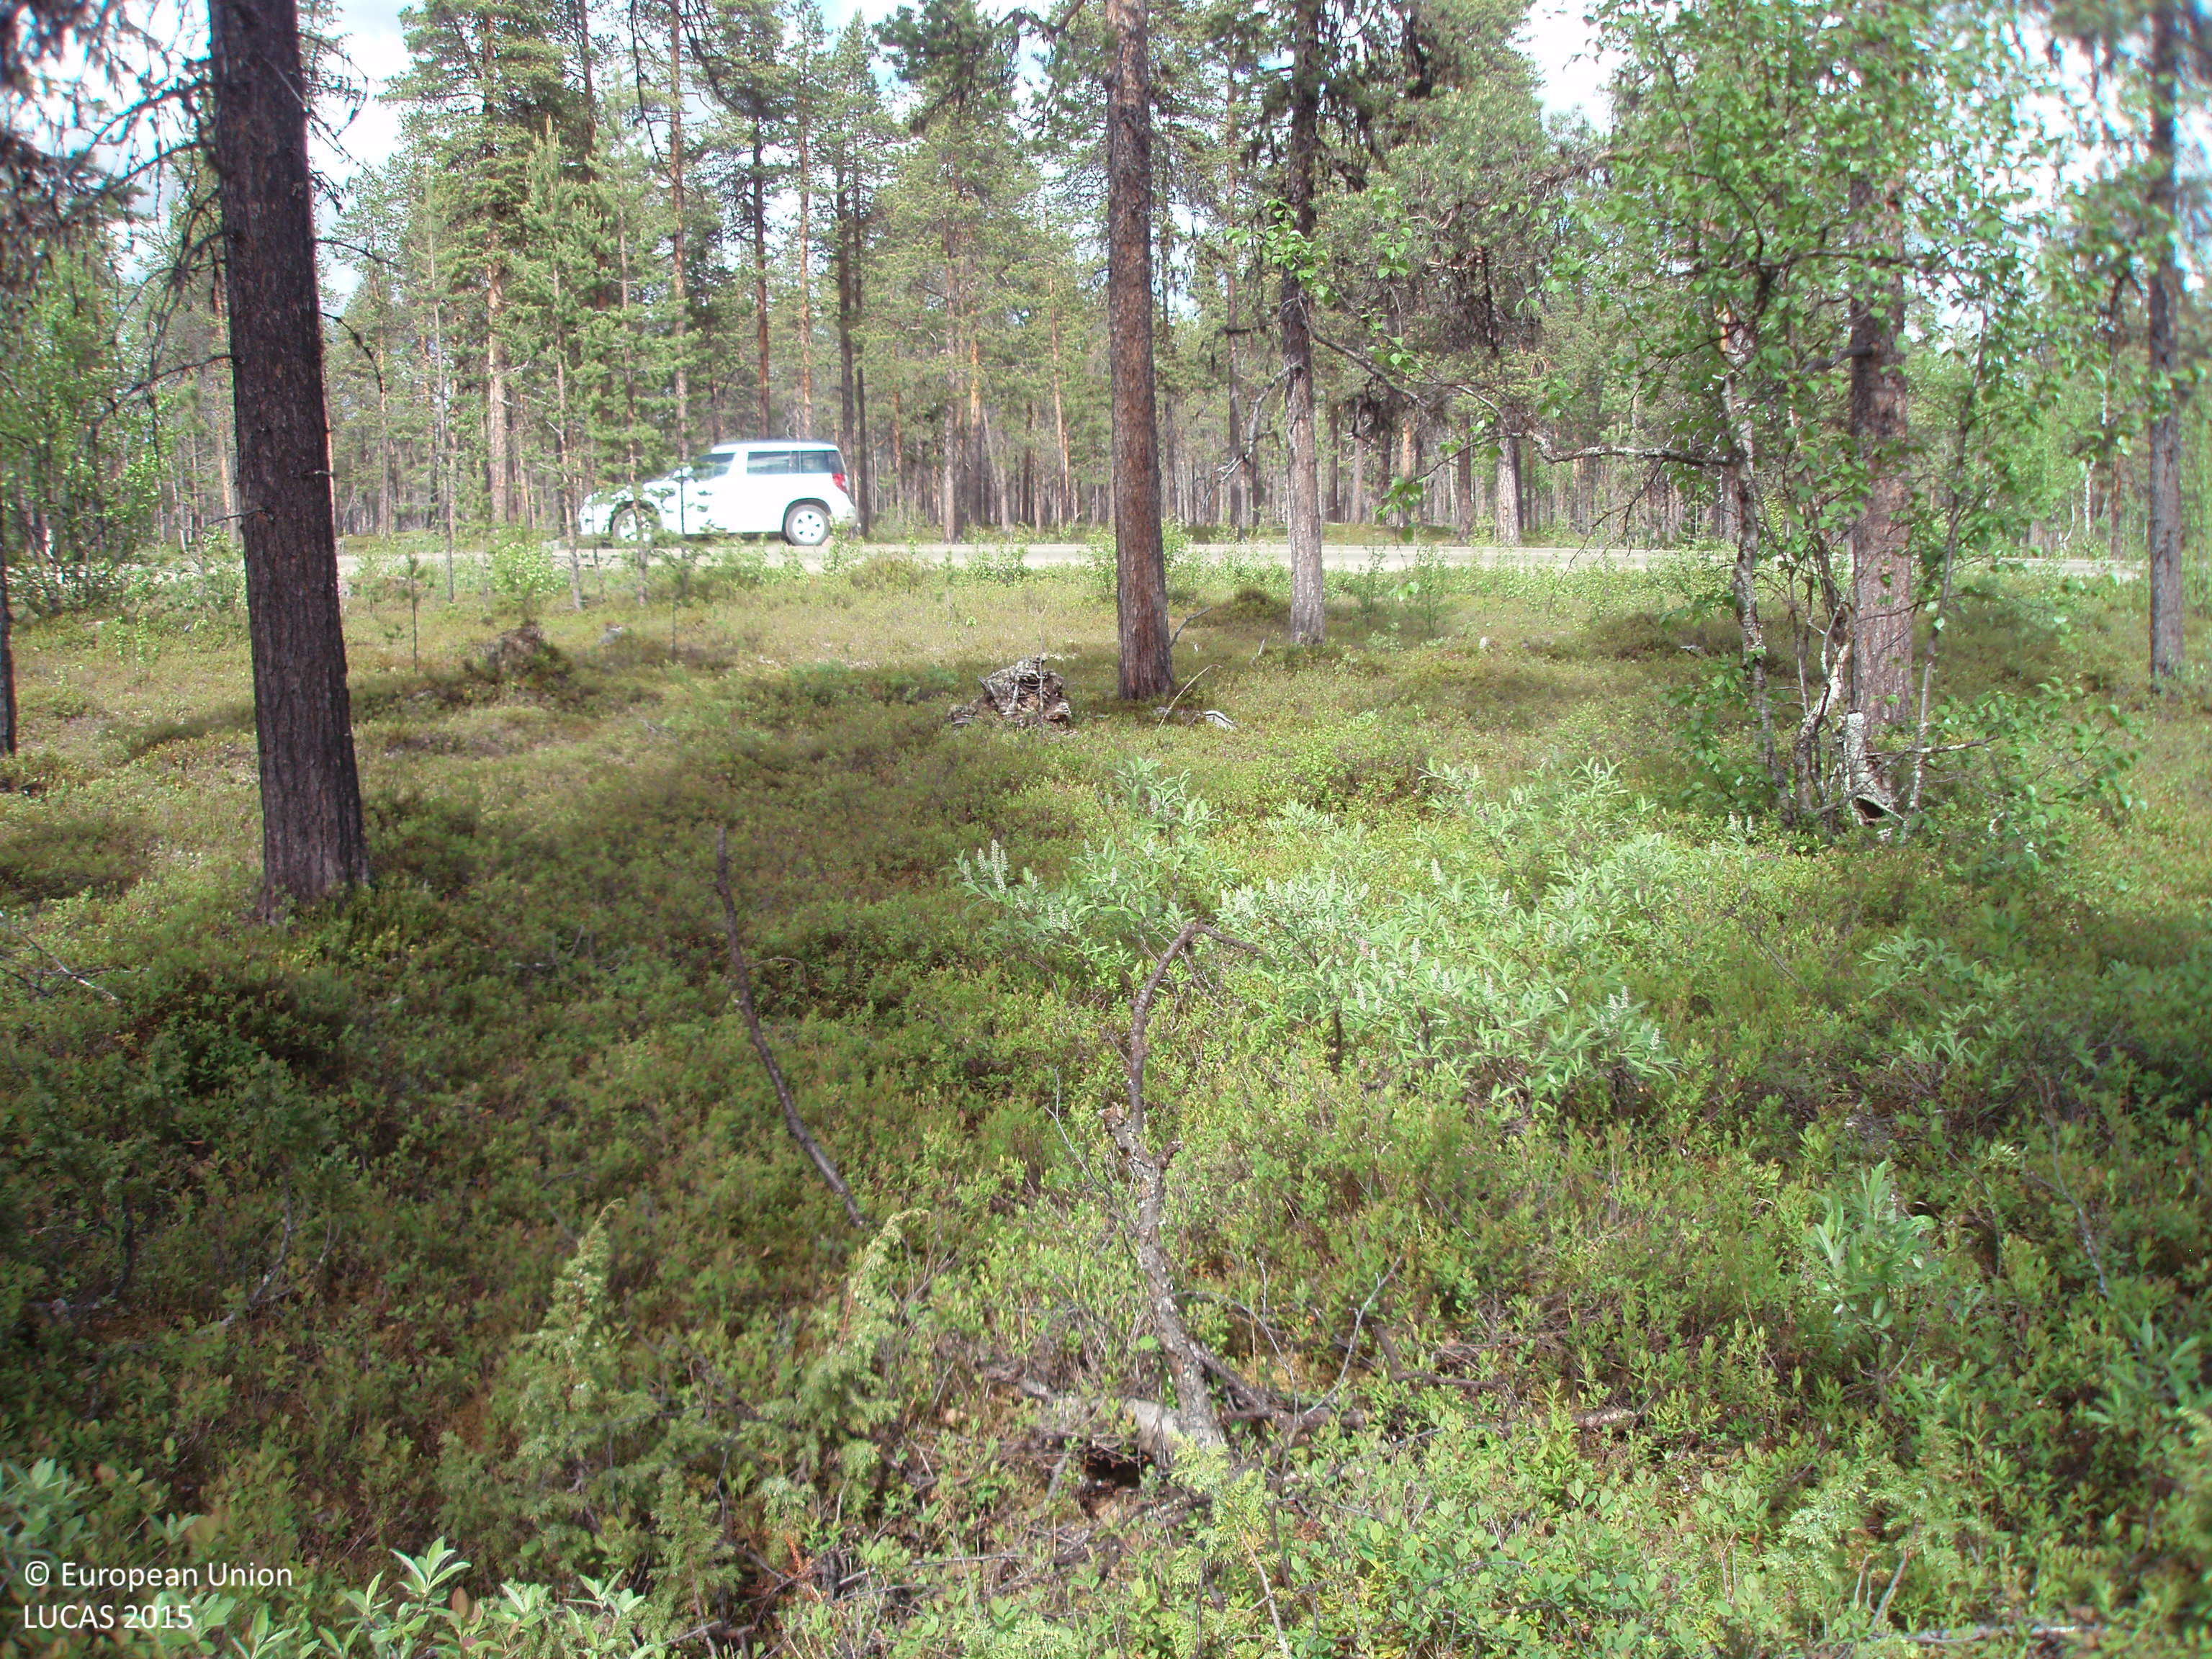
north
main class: Woodland
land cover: Pine dominated mixed woodland
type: boreal forest
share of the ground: > 75 %
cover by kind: coniferous forest trees 40 %, broadleaved forest trees 35 %, shrubs 25 %
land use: Forestry
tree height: > 5 m
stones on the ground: > 50 %
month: July
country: FI
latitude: 68.9083
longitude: 25.7938
